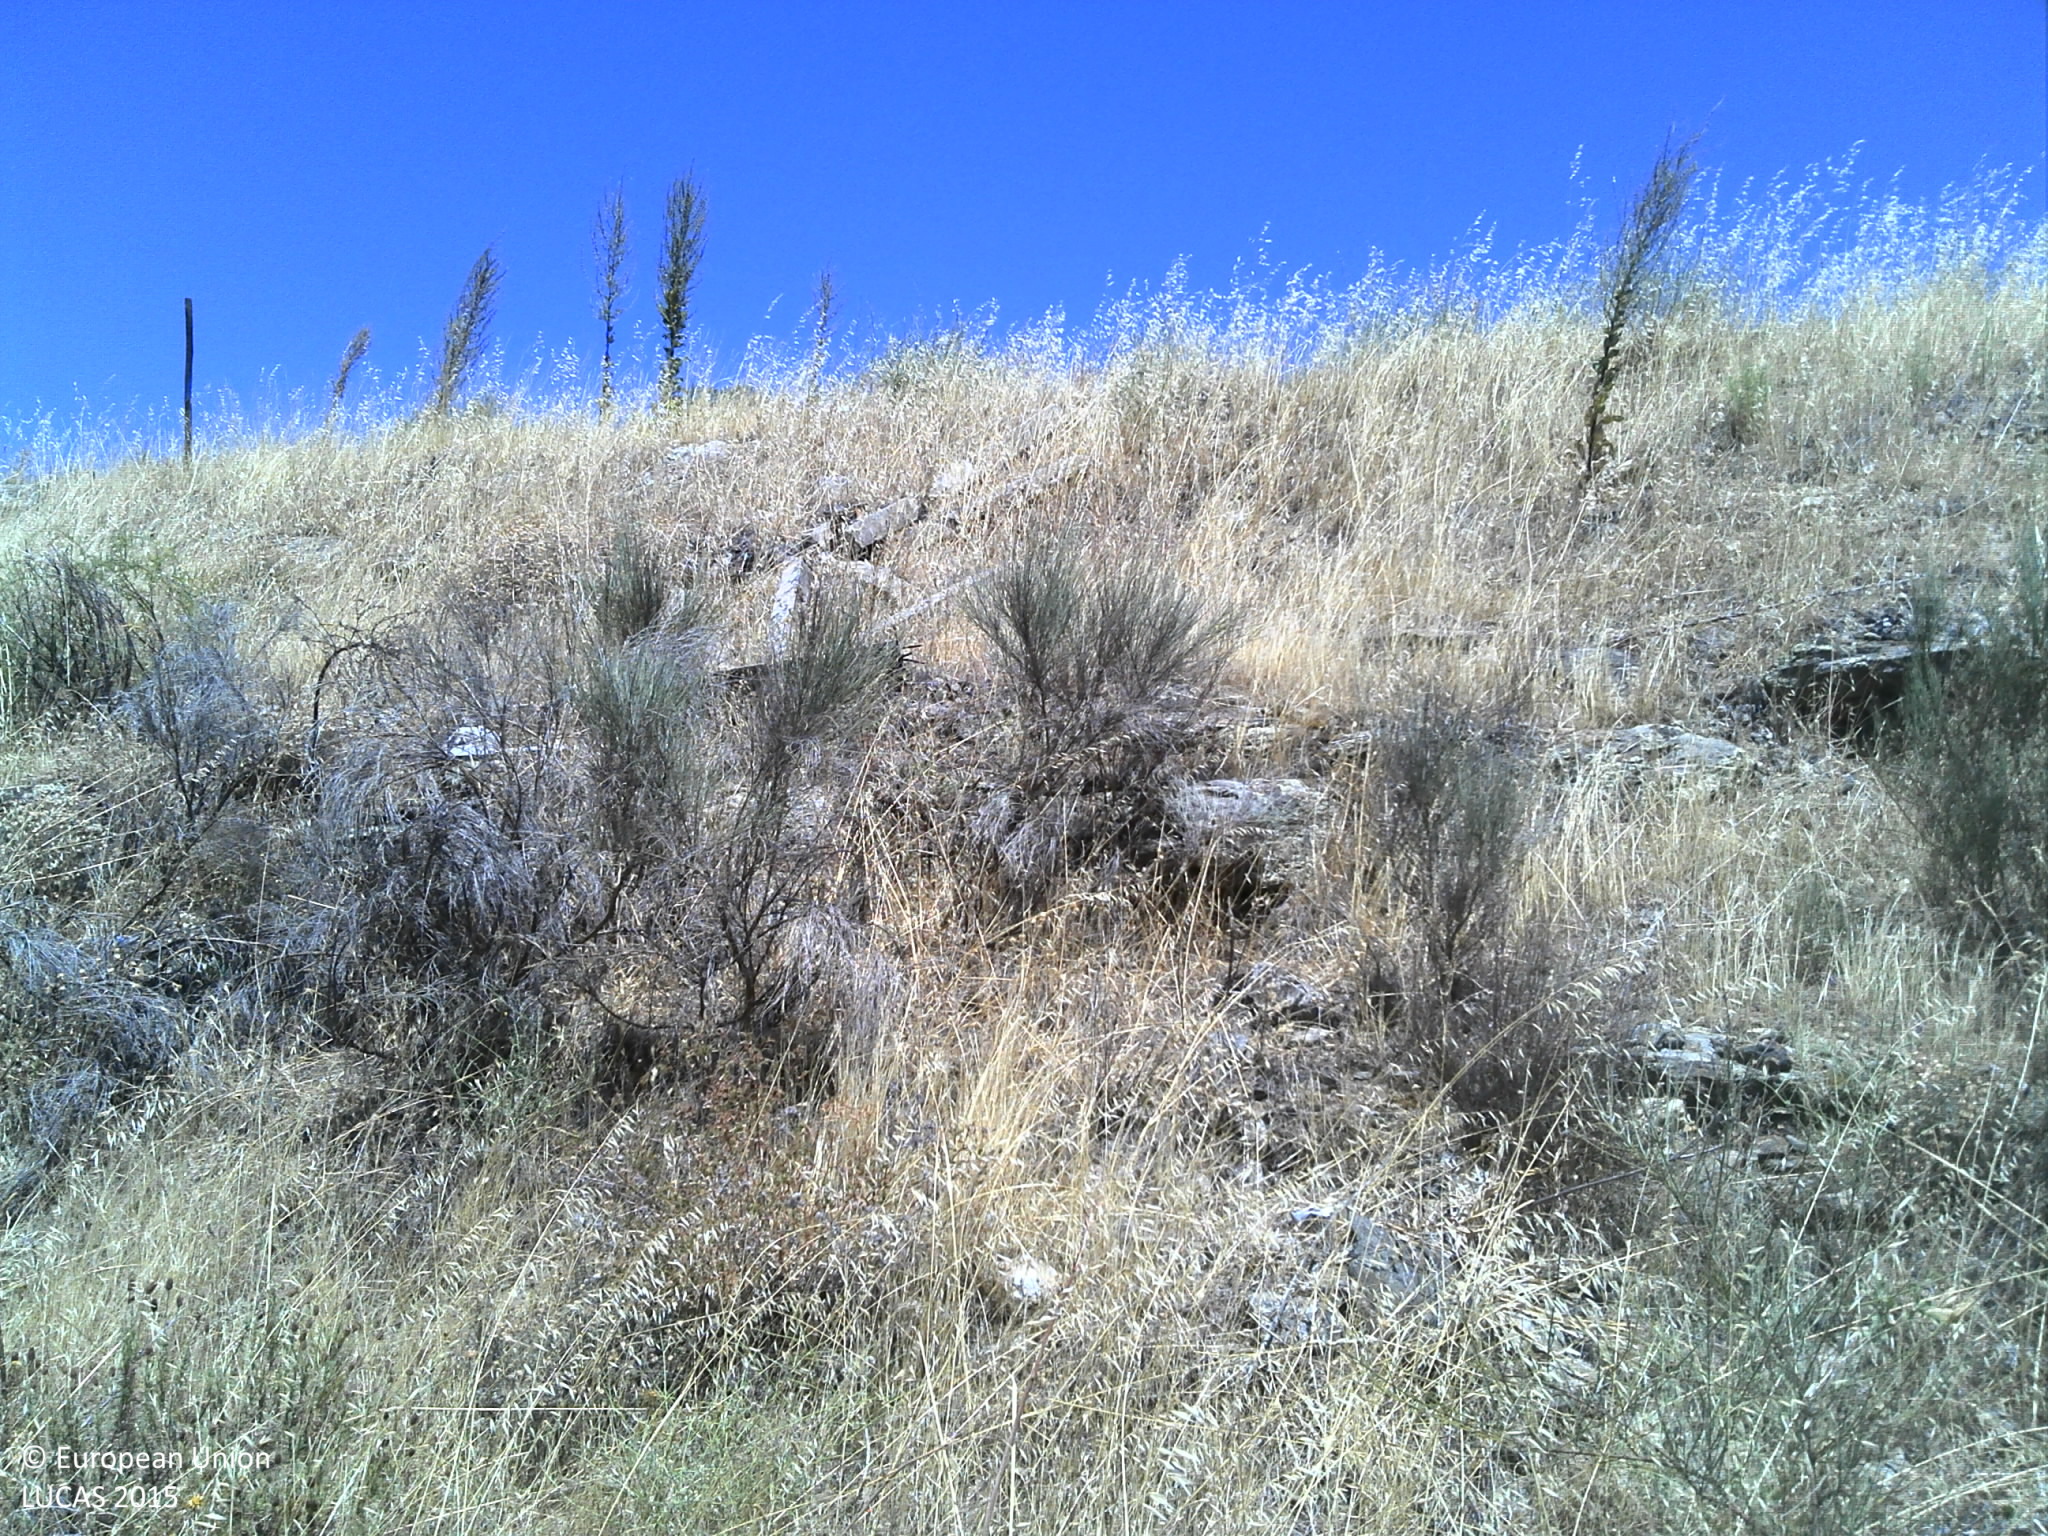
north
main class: Shrubland
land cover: Shrubland without tree cover
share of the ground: > 75 %
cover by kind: shrubs 80 %, herbaceous plants 20 %
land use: Abandoned areas
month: July
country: PT
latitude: 41.3138
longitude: -7.1127
